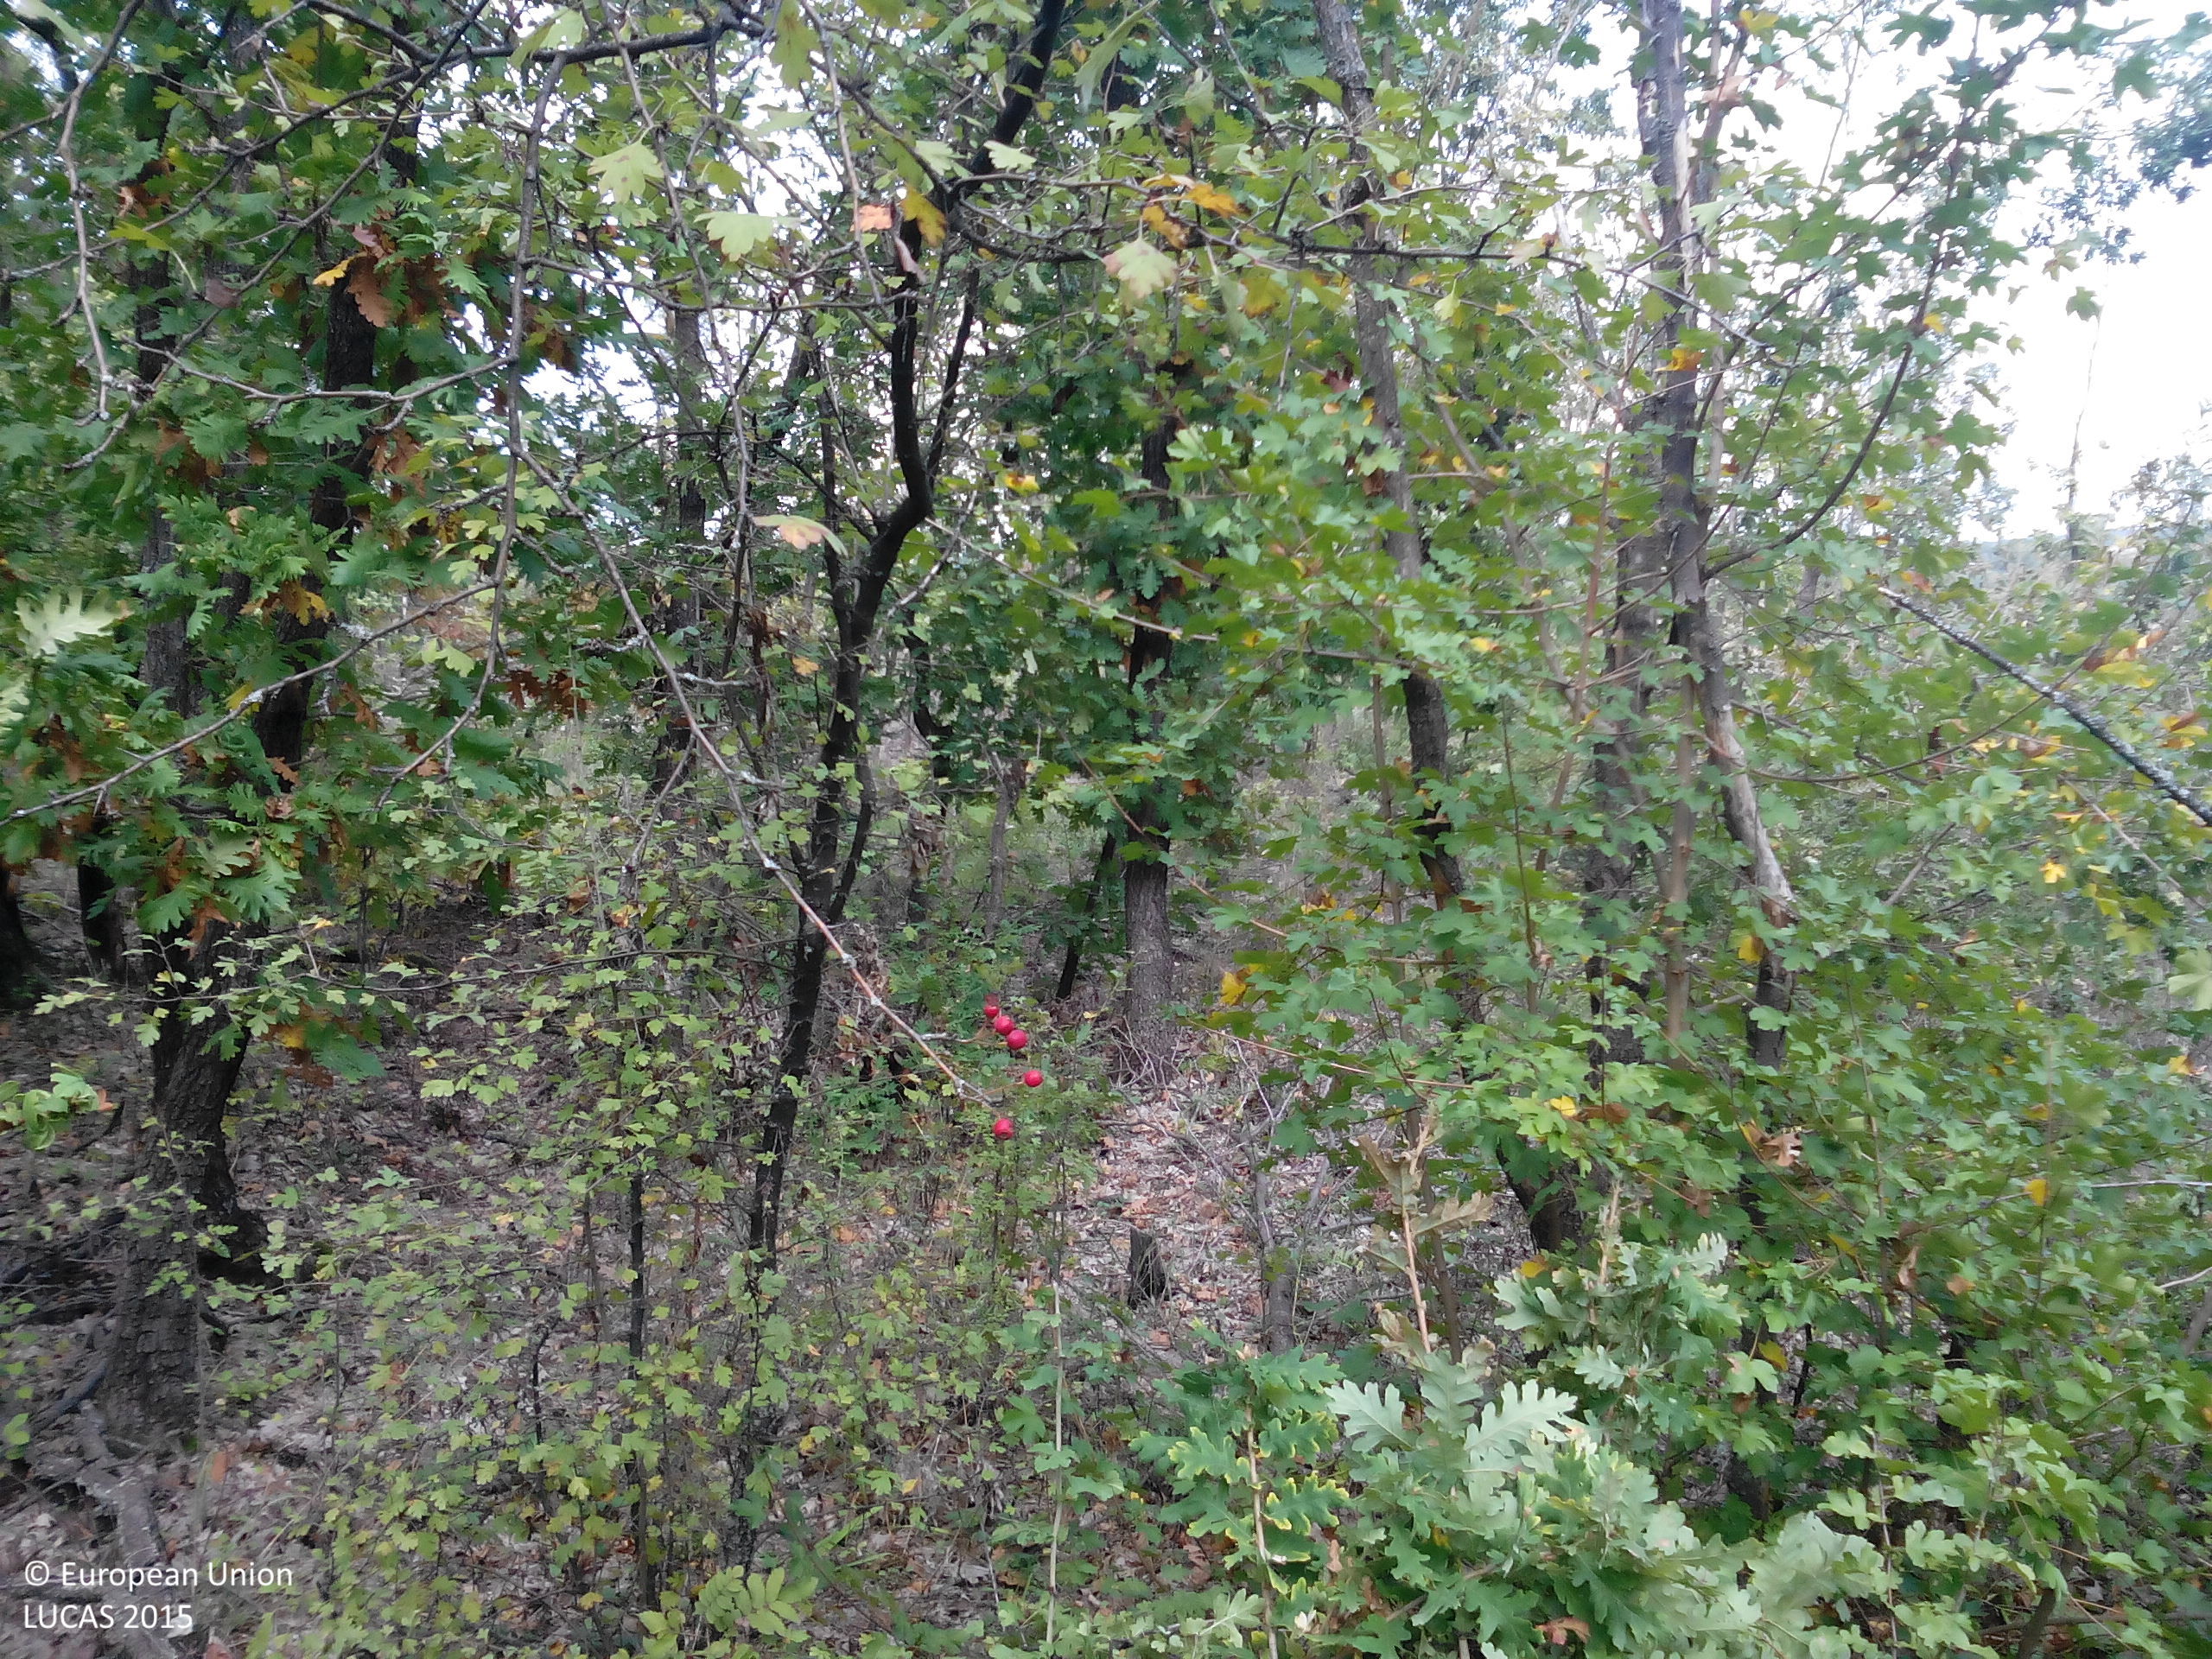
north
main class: Woodland
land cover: Broadleaved woodland
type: acidophilous oak and oak-birch forest
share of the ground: > 75 %
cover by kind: broadleaved forest trees 75 %, shrubs 15 %, herbaceous plants 10 %
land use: Forestry
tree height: > 5 m
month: October
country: BG
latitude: 43.2103
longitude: 24.0208
